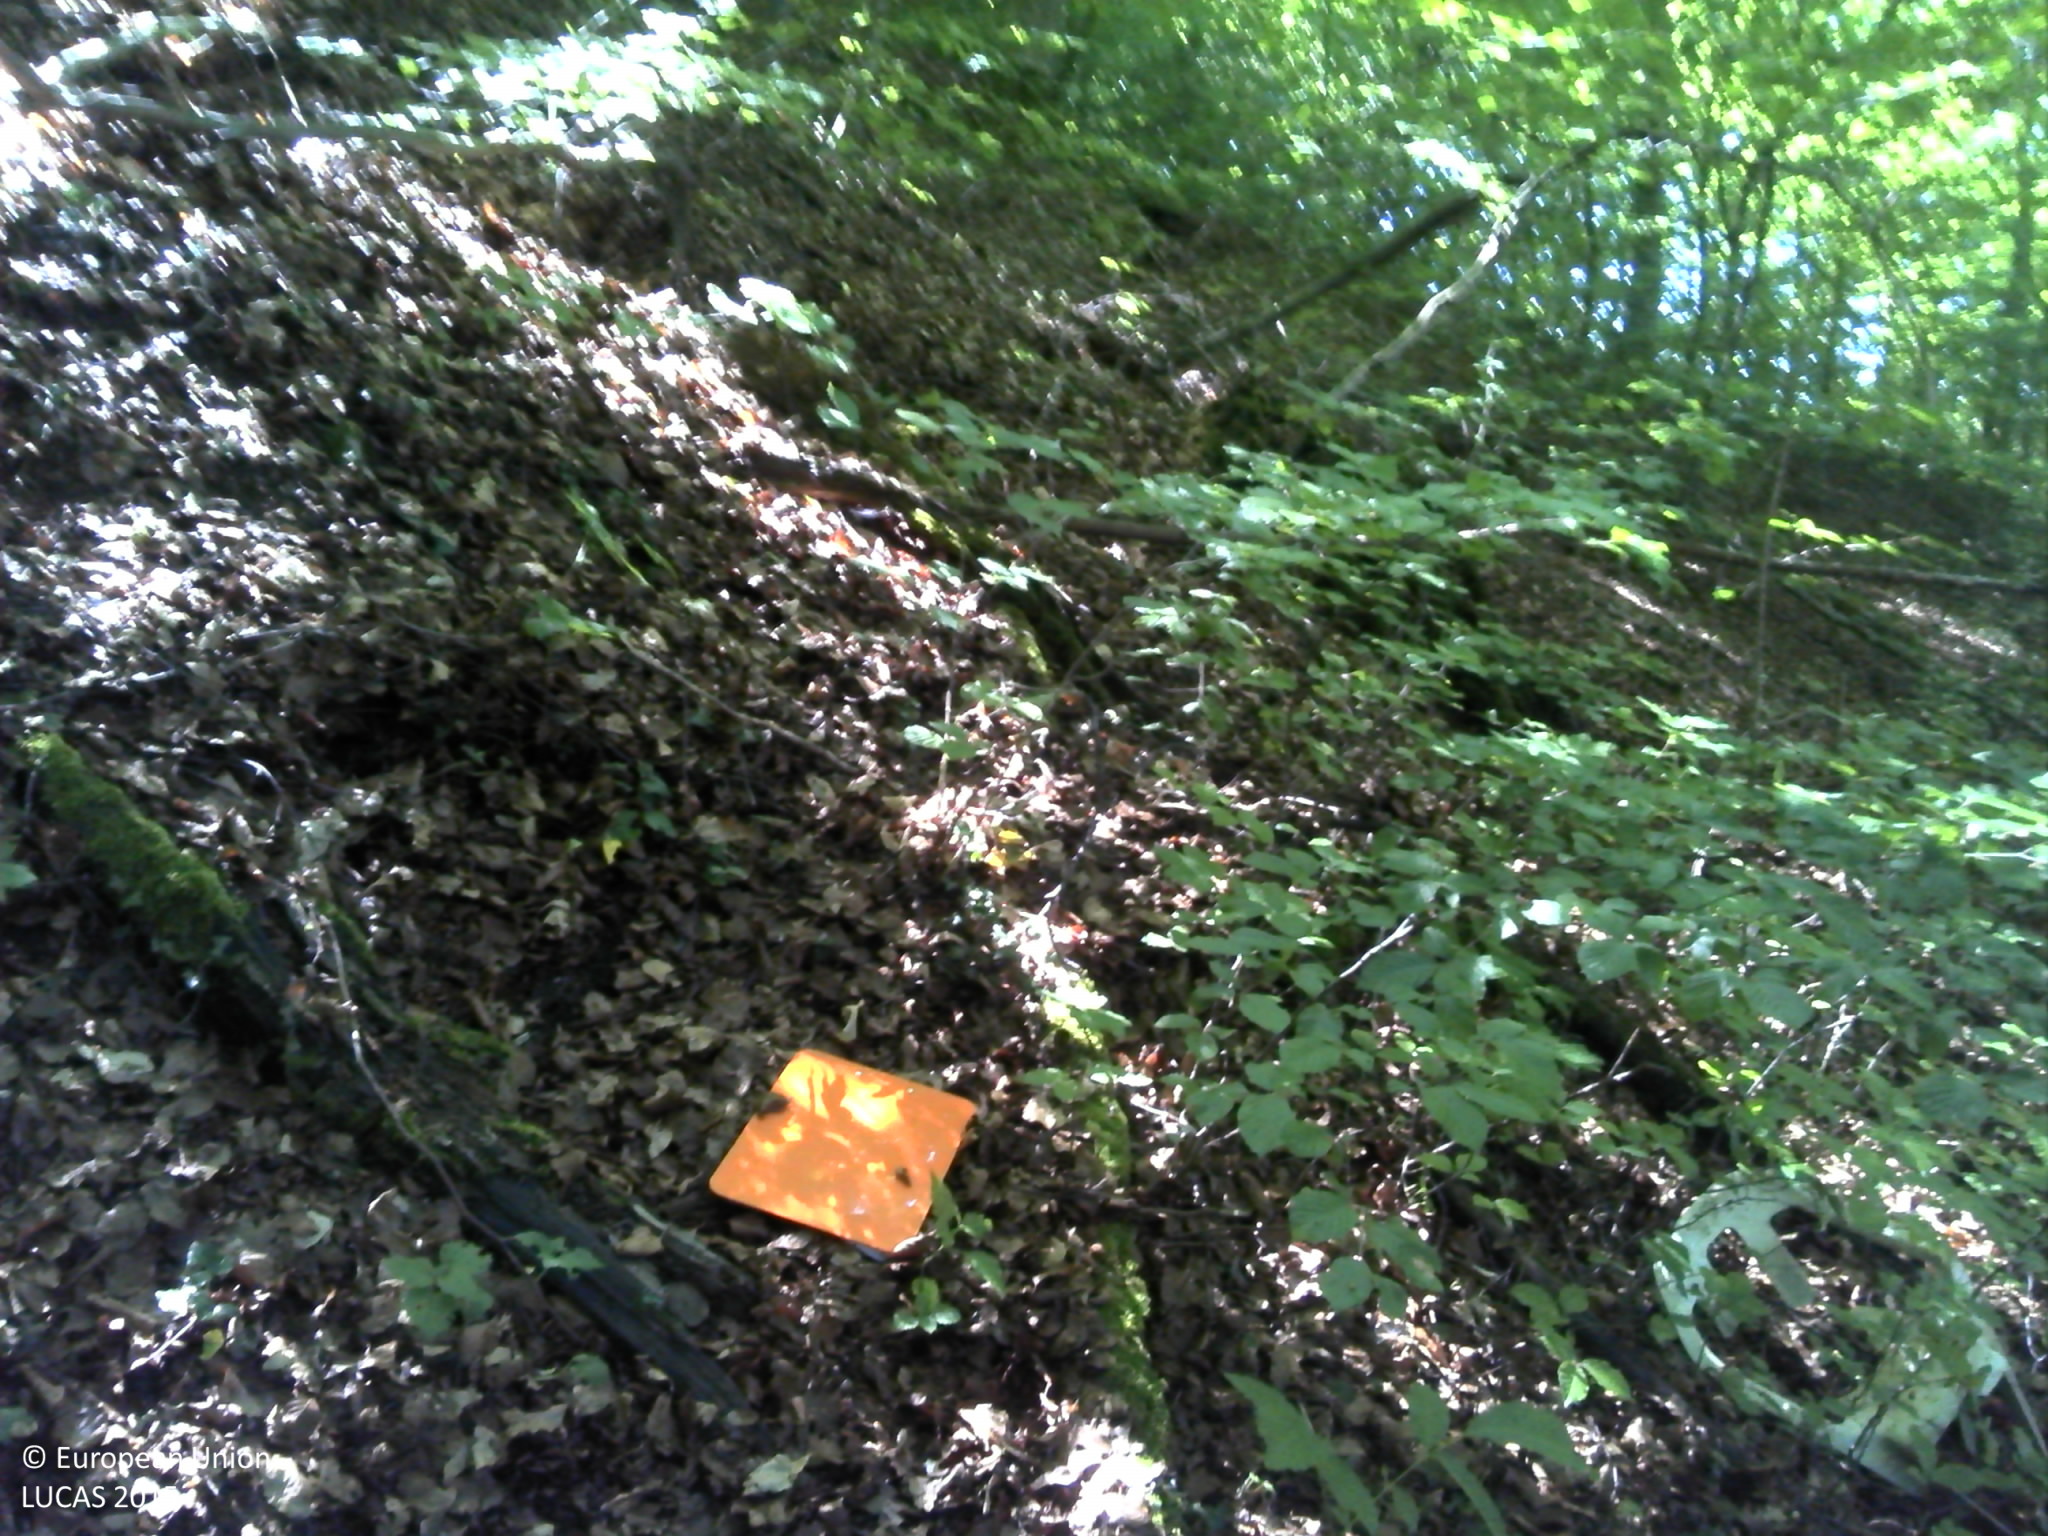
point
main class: Woodland
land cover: Broadleaved woodland
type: acidophilous oak and oak-birch forest
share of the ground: > 75 %
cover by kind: broadleaved forest trees 100 %
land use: Forestry
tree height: > 5 m
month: June
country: FR
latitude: 49.4643
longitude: 5.9565
